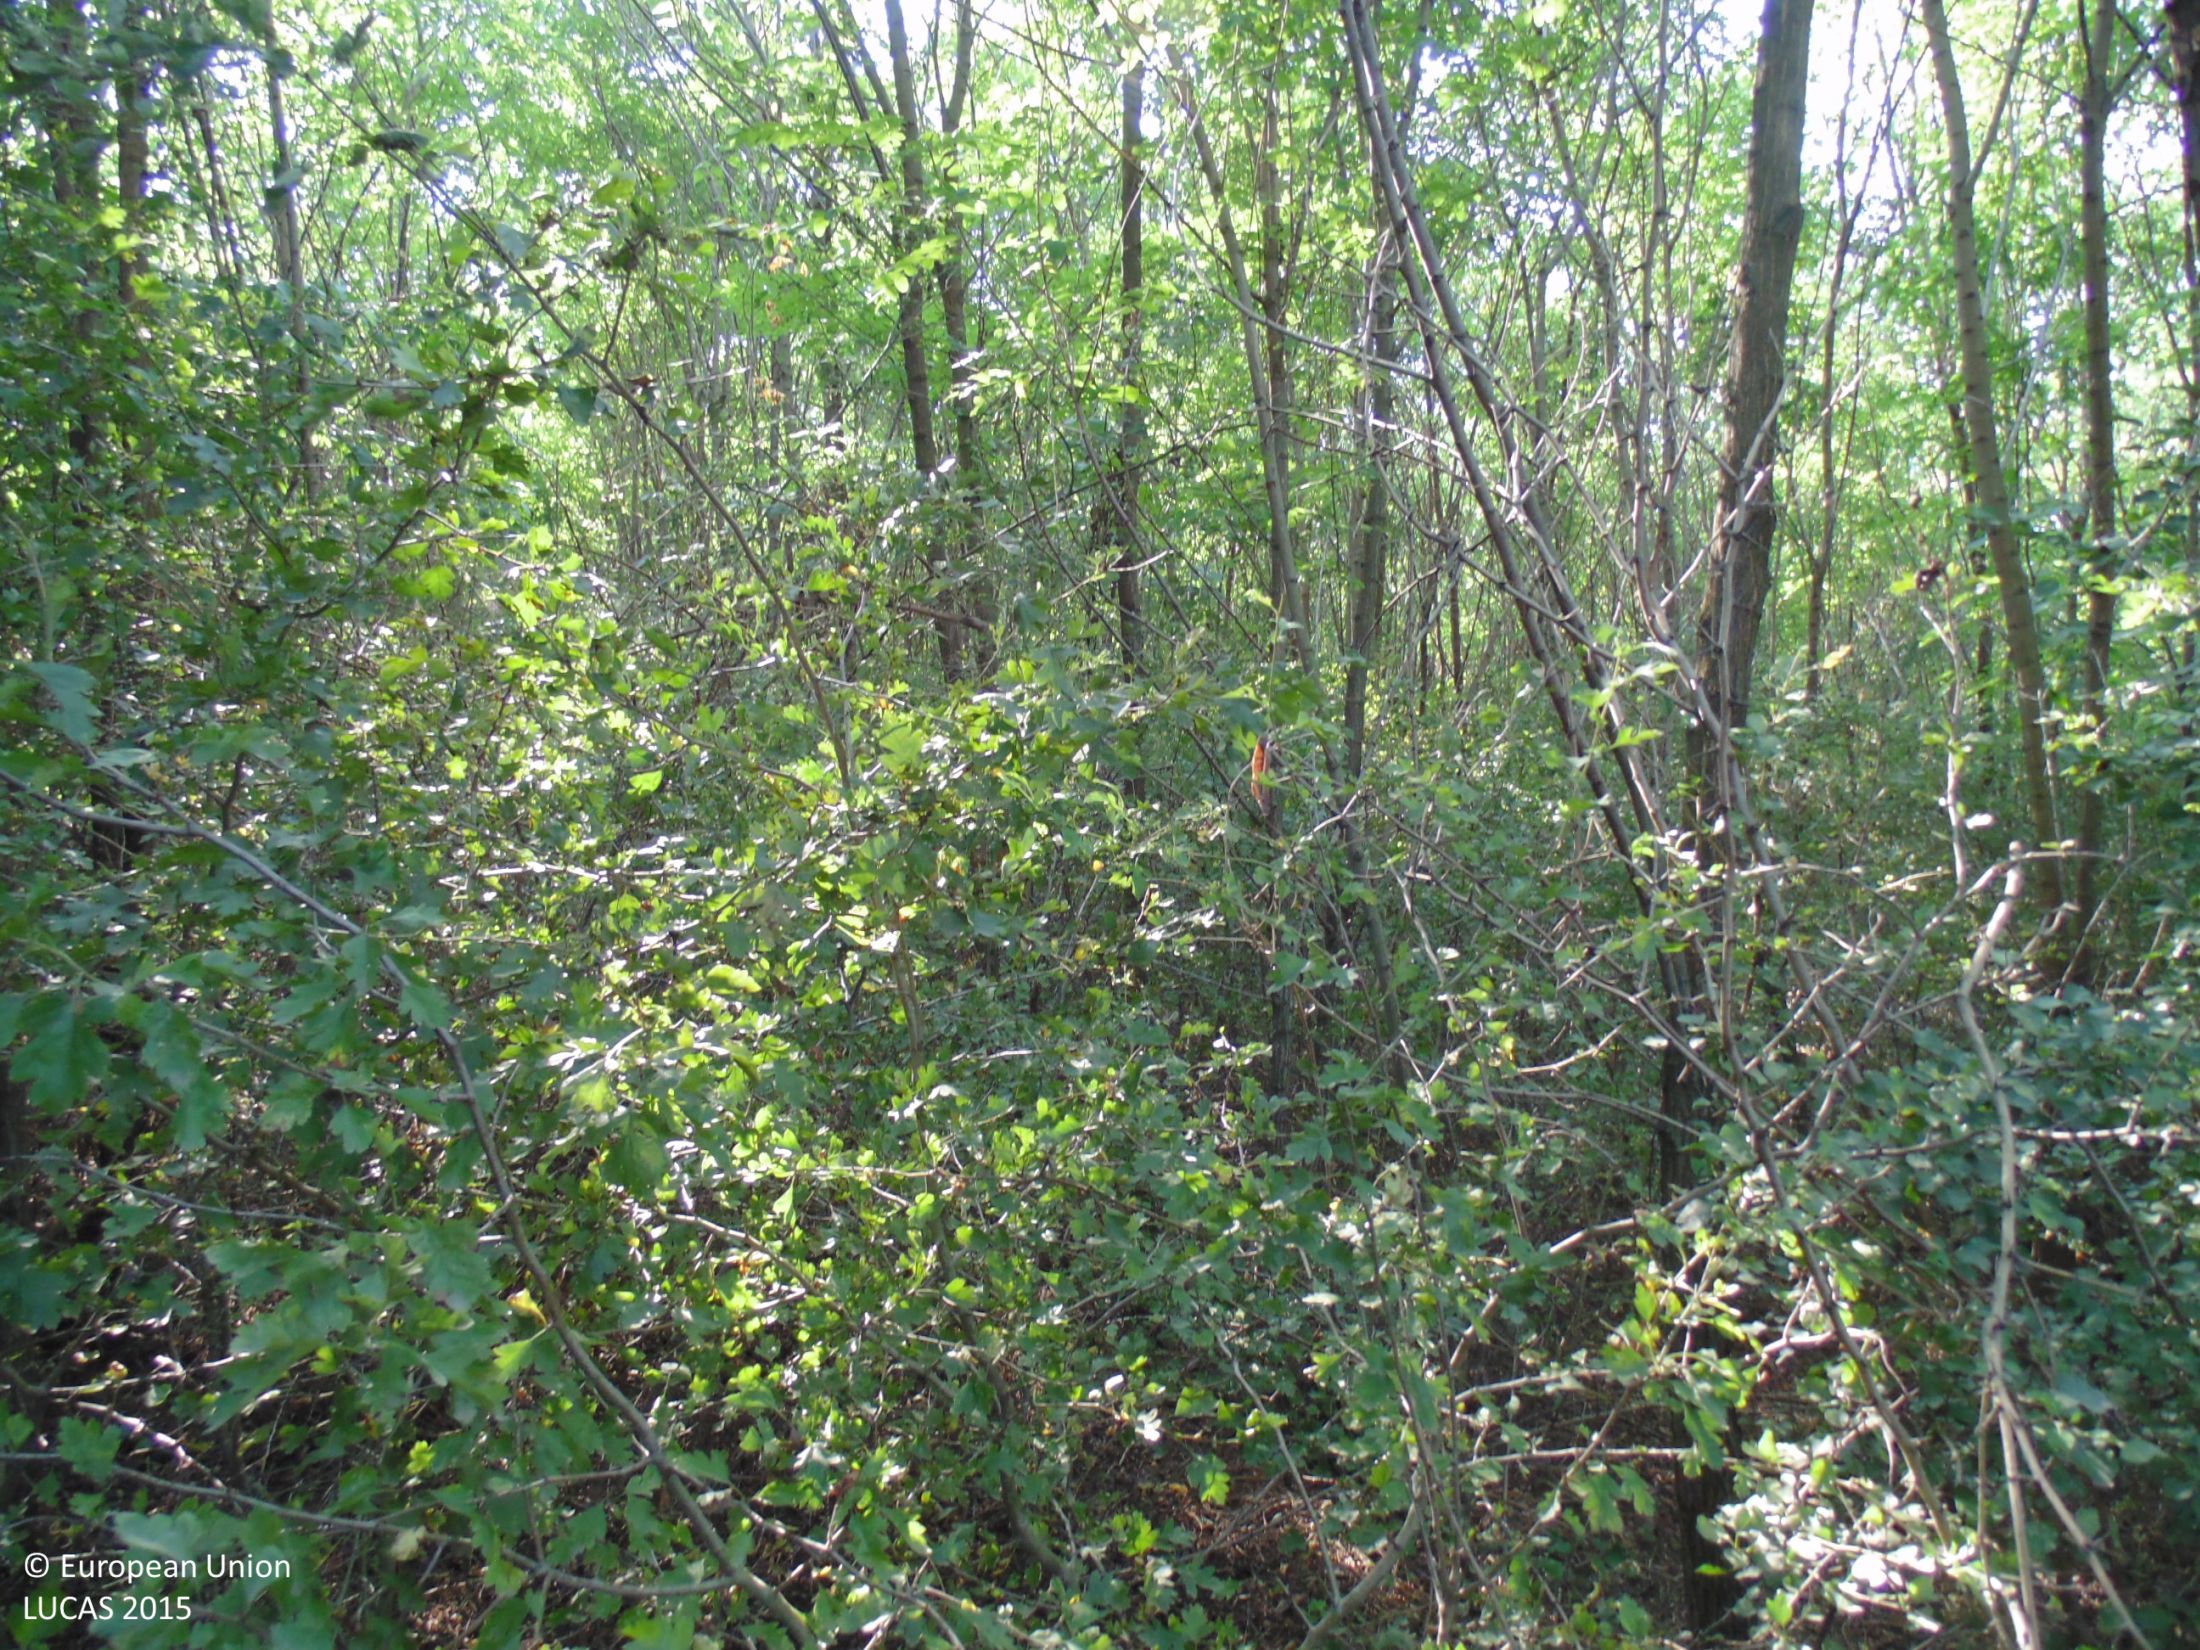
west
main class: Woodland
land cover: Broadleaved woodland
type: mesophytic deciduous forest
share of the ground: > 75 %
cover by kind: broadleaved forest trees 90 %, shrubs 5 %, unconsolidated bare surface 5 %
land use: Forestry
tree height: > 5 m
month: August
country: BG
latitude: 43.9238
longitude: 27.3574
